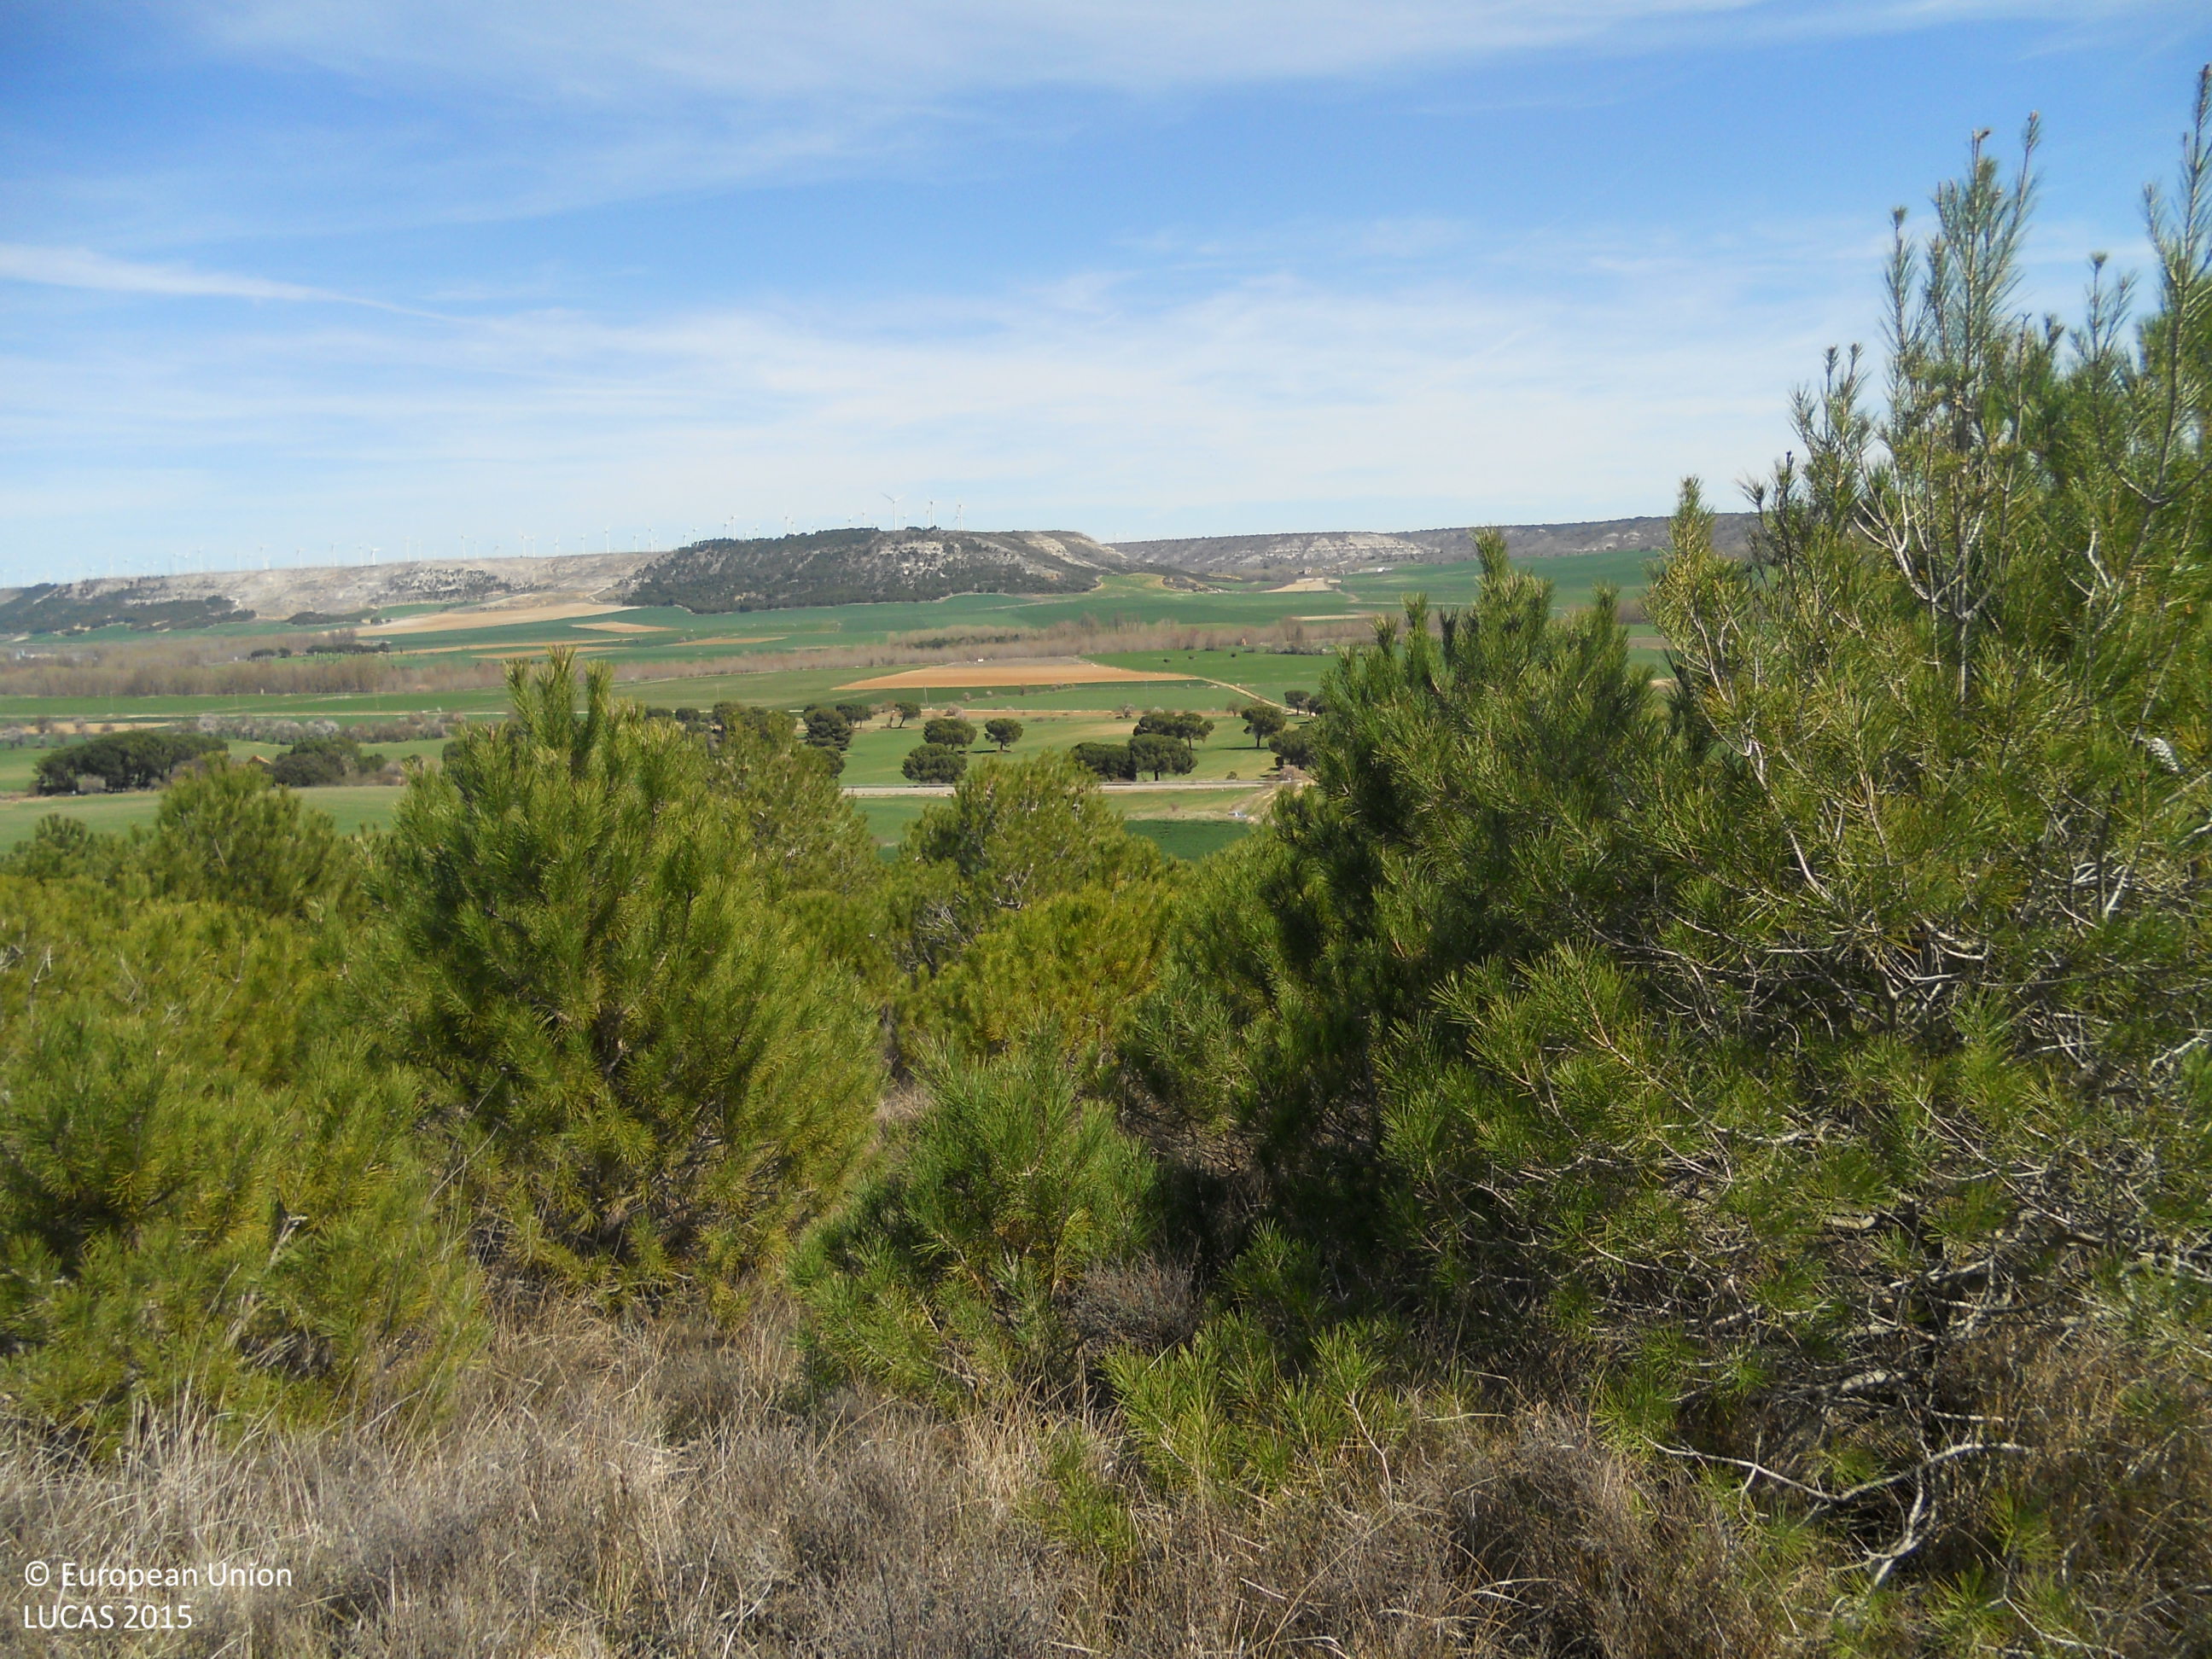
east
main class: Woodland
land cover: Pine dominated coniferous woodland
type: coniferous forest of the mediterranean region
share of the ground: 50 - 75 %
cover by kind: coniferous forest trees 65 %, herbaceous plants 20 %, shrubs 10 %, consolidated bare surface 5 %
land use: Forestry
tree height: > 5 m
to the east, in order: Pine dominated coniferous woodland; Common wheat; Grassland with sparse tree/shrub cover; Tracks; Grassland with sparse tree/shrub cover; Other bare soil; Grass margins; Tracks; Grass margins; Barley
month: April
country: ES
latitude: 42.1692
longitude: -4.2667
